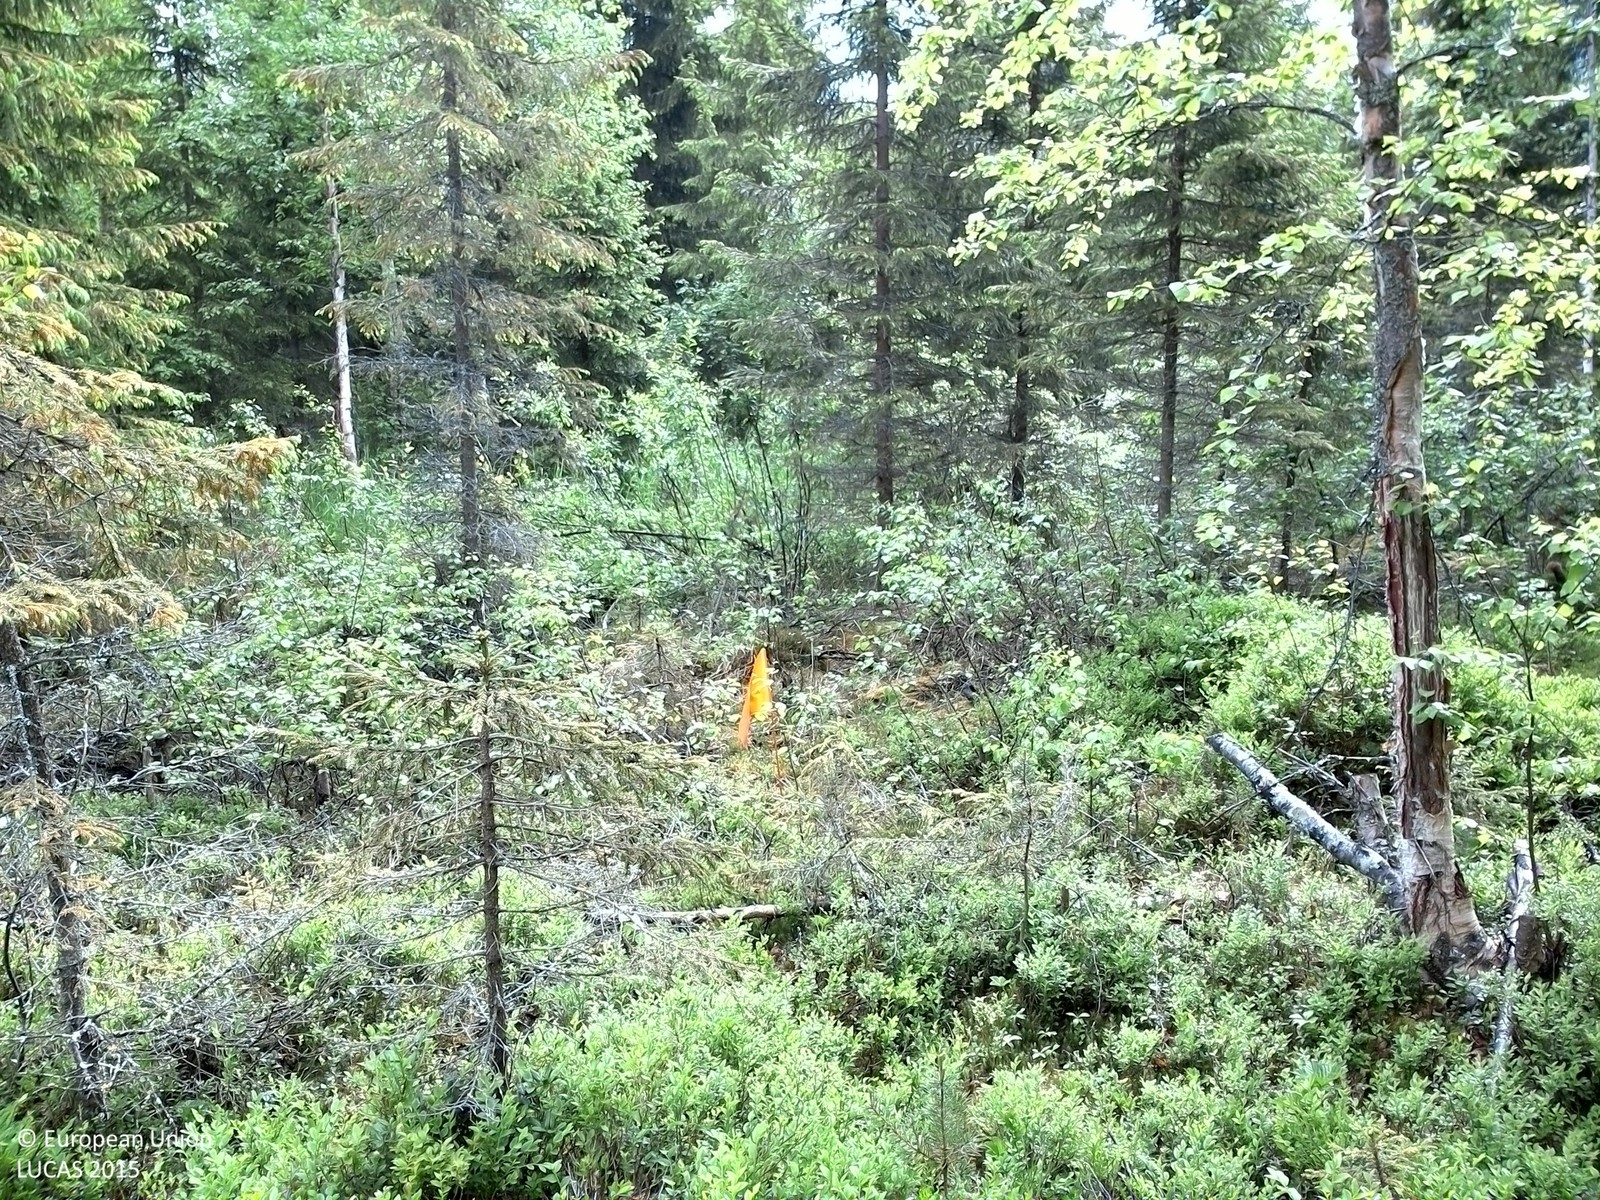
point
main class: Woodland
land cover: Spruce dominated mixed woodland
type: boreal forest
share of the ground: 50 - 75 %
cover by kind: coniferous forest trees 40 %, shrubs 30 %, broadleaved forest trees 20 %, herbaceous plants 10 %
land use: Forestry
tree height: < 5 m
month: June
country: SE
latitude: 63.5046
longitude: 18.0313
